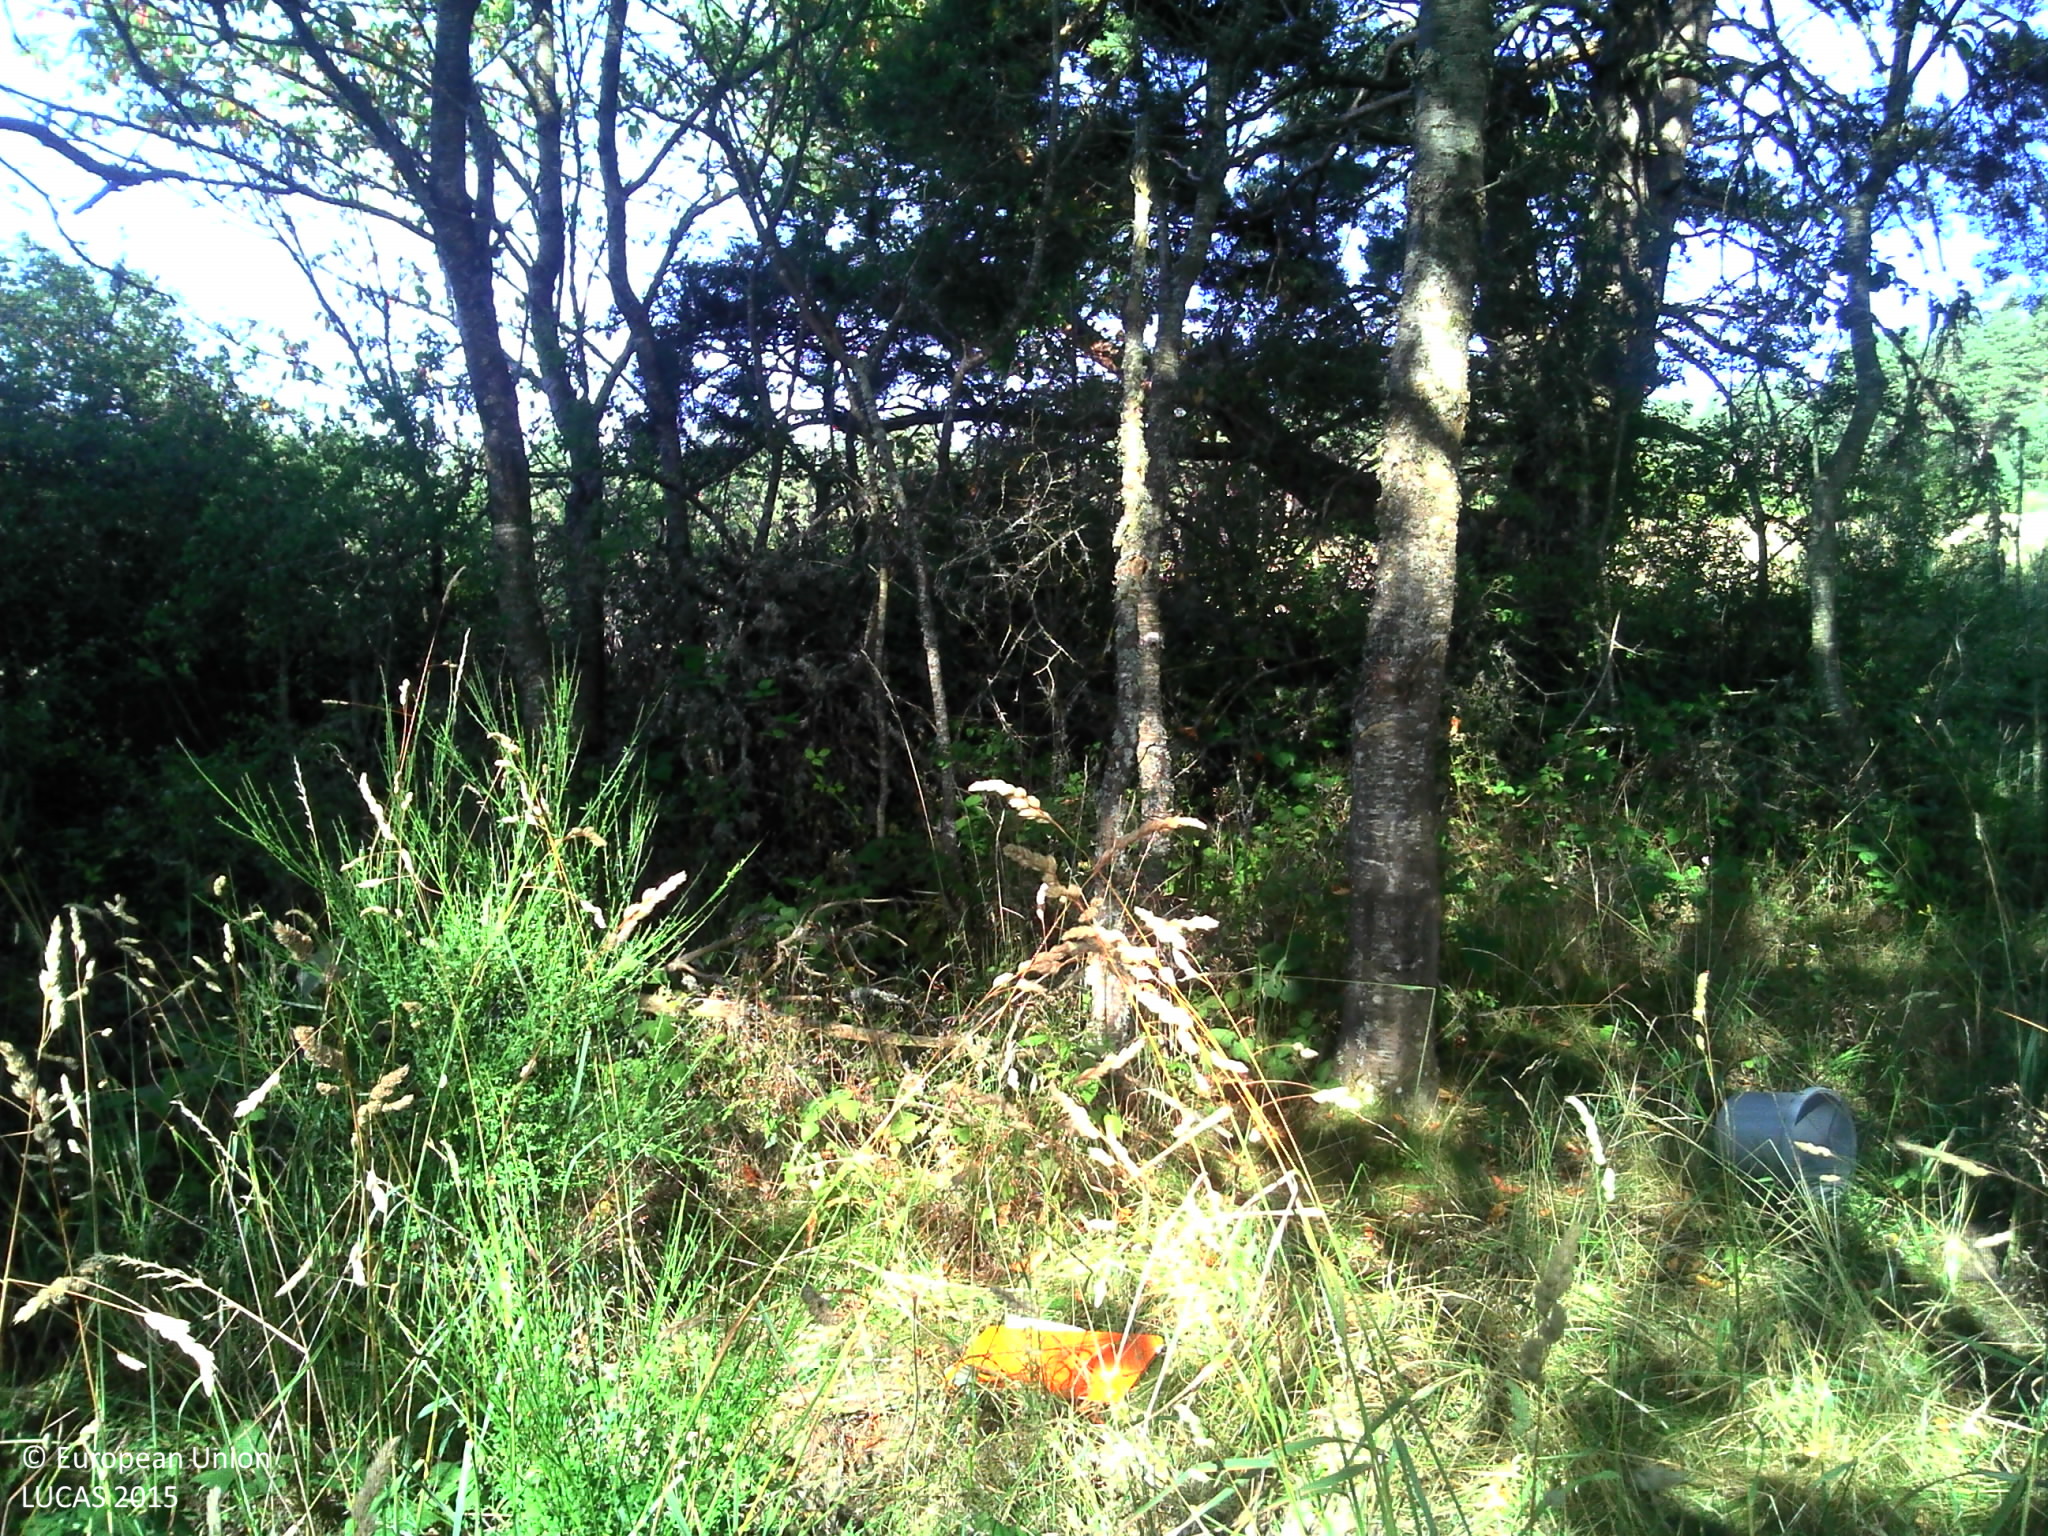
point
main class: Woodland
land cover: Pine dominated mixed woodland
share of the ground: > 75 %
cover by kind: coniferous forest trees 75 %, broadleaved forest trees 25 %
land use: Semi-natural and natural areas not in use
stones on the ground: < 10 %
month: July
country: FR
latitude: 45.0276
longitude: 3.4160
